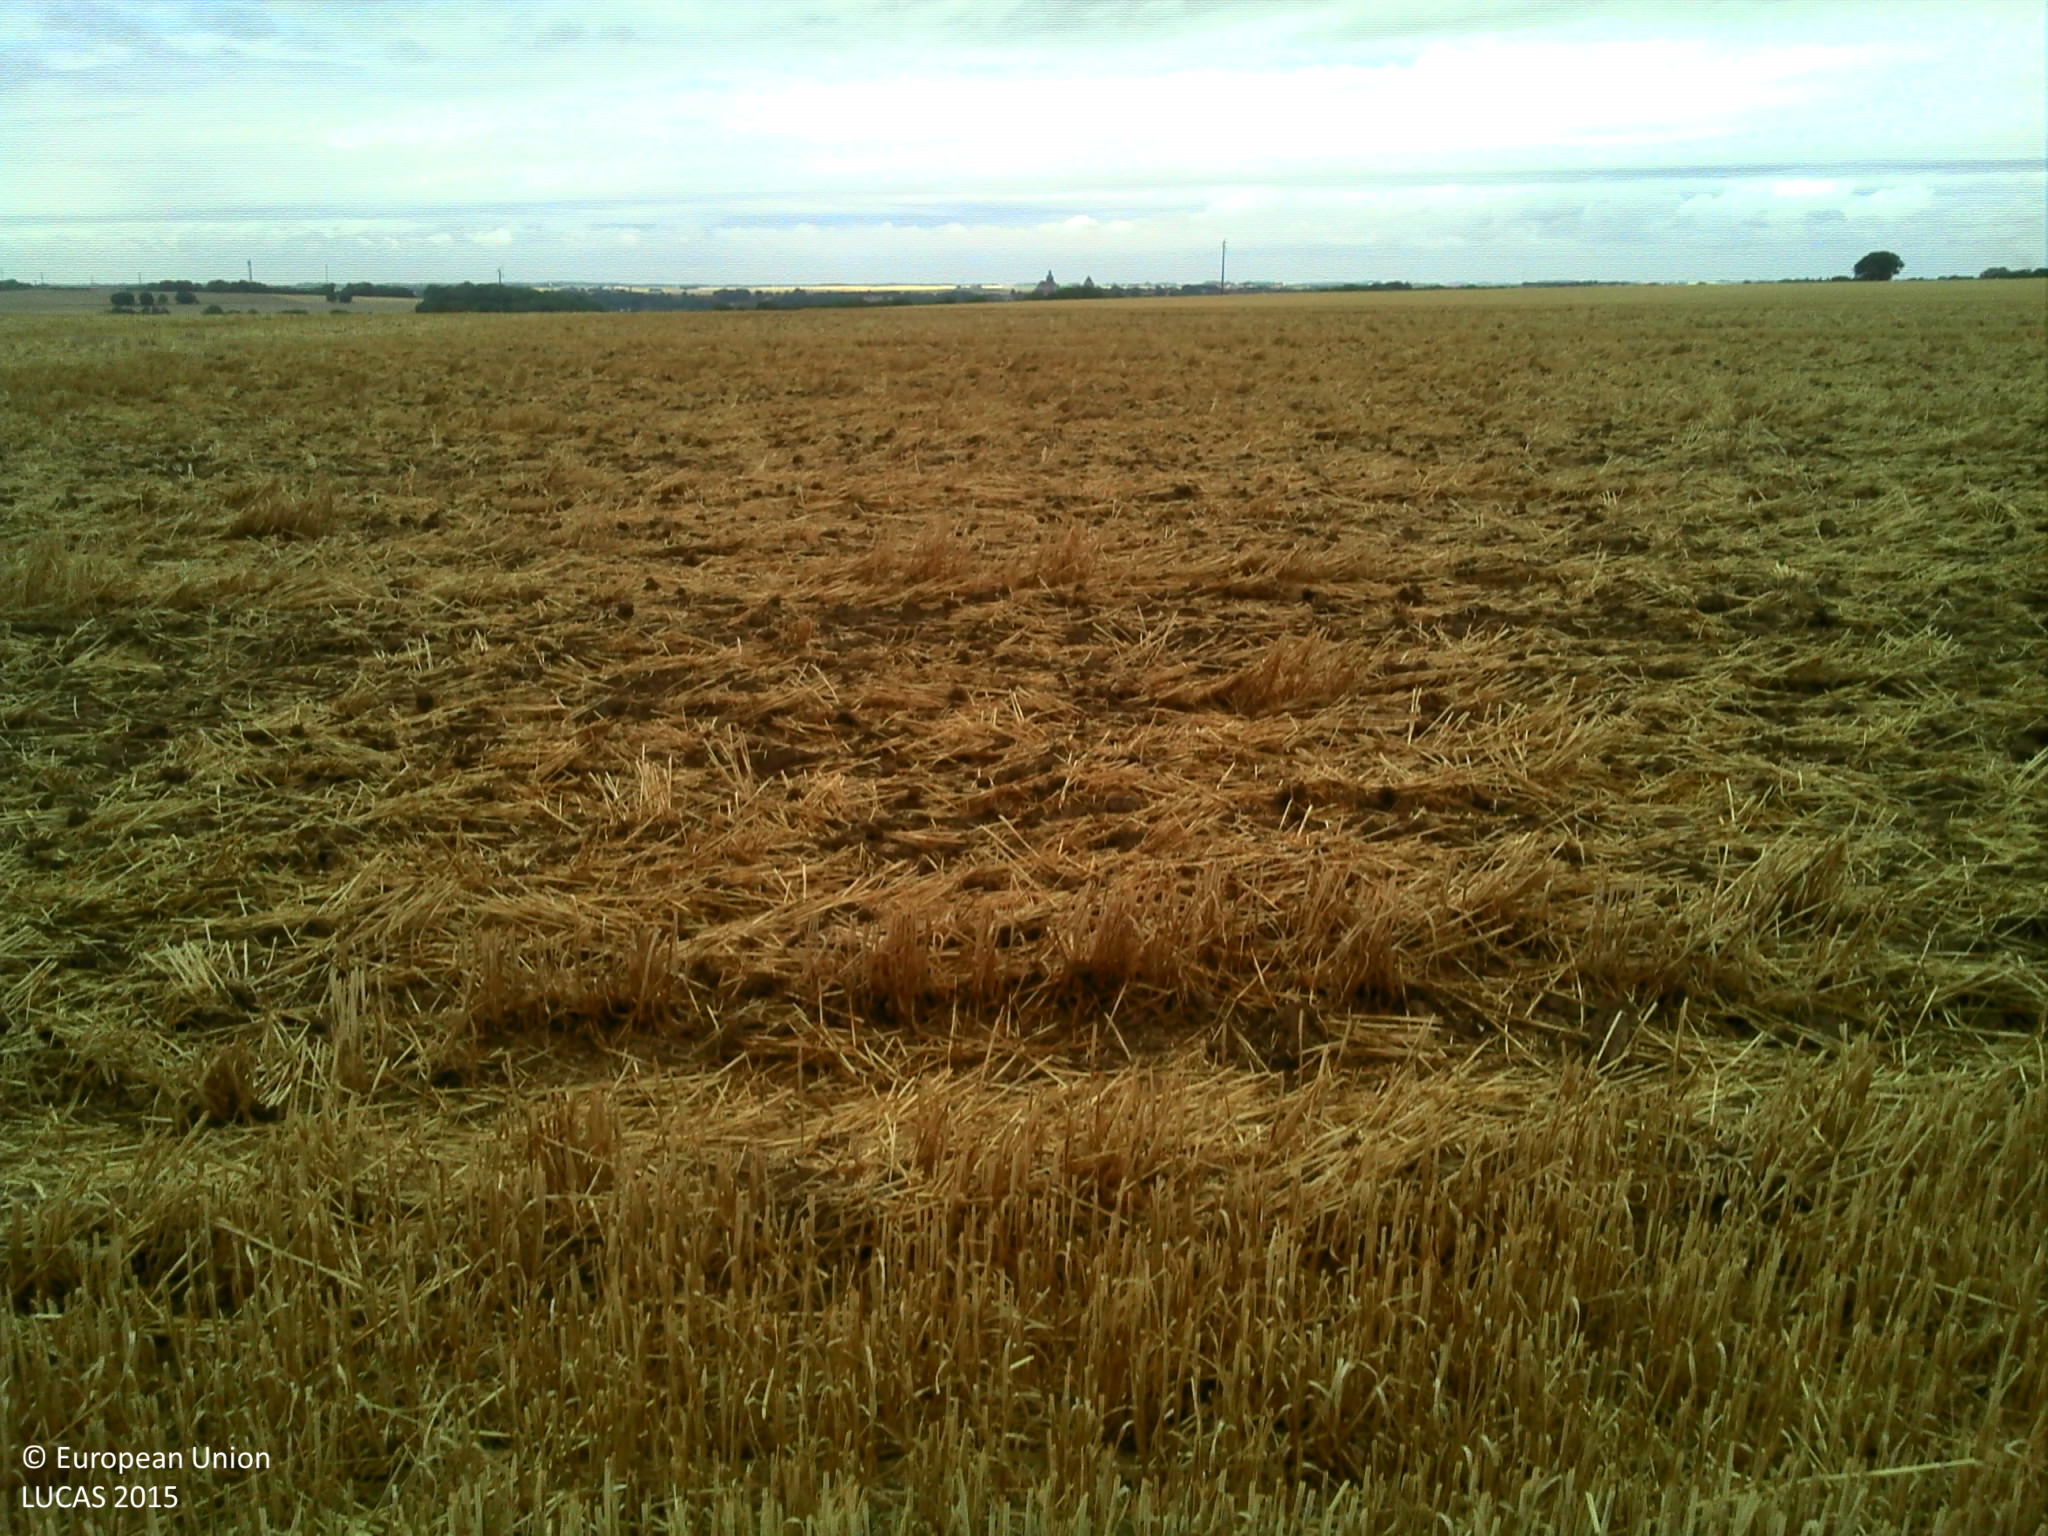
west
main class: Cropland
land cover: Common wheat
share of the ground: > 75 %
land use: Agriculture (excluding fallow land and kitchen gardens)
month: August
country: FR
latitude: 48.5637
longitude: 3.3398
